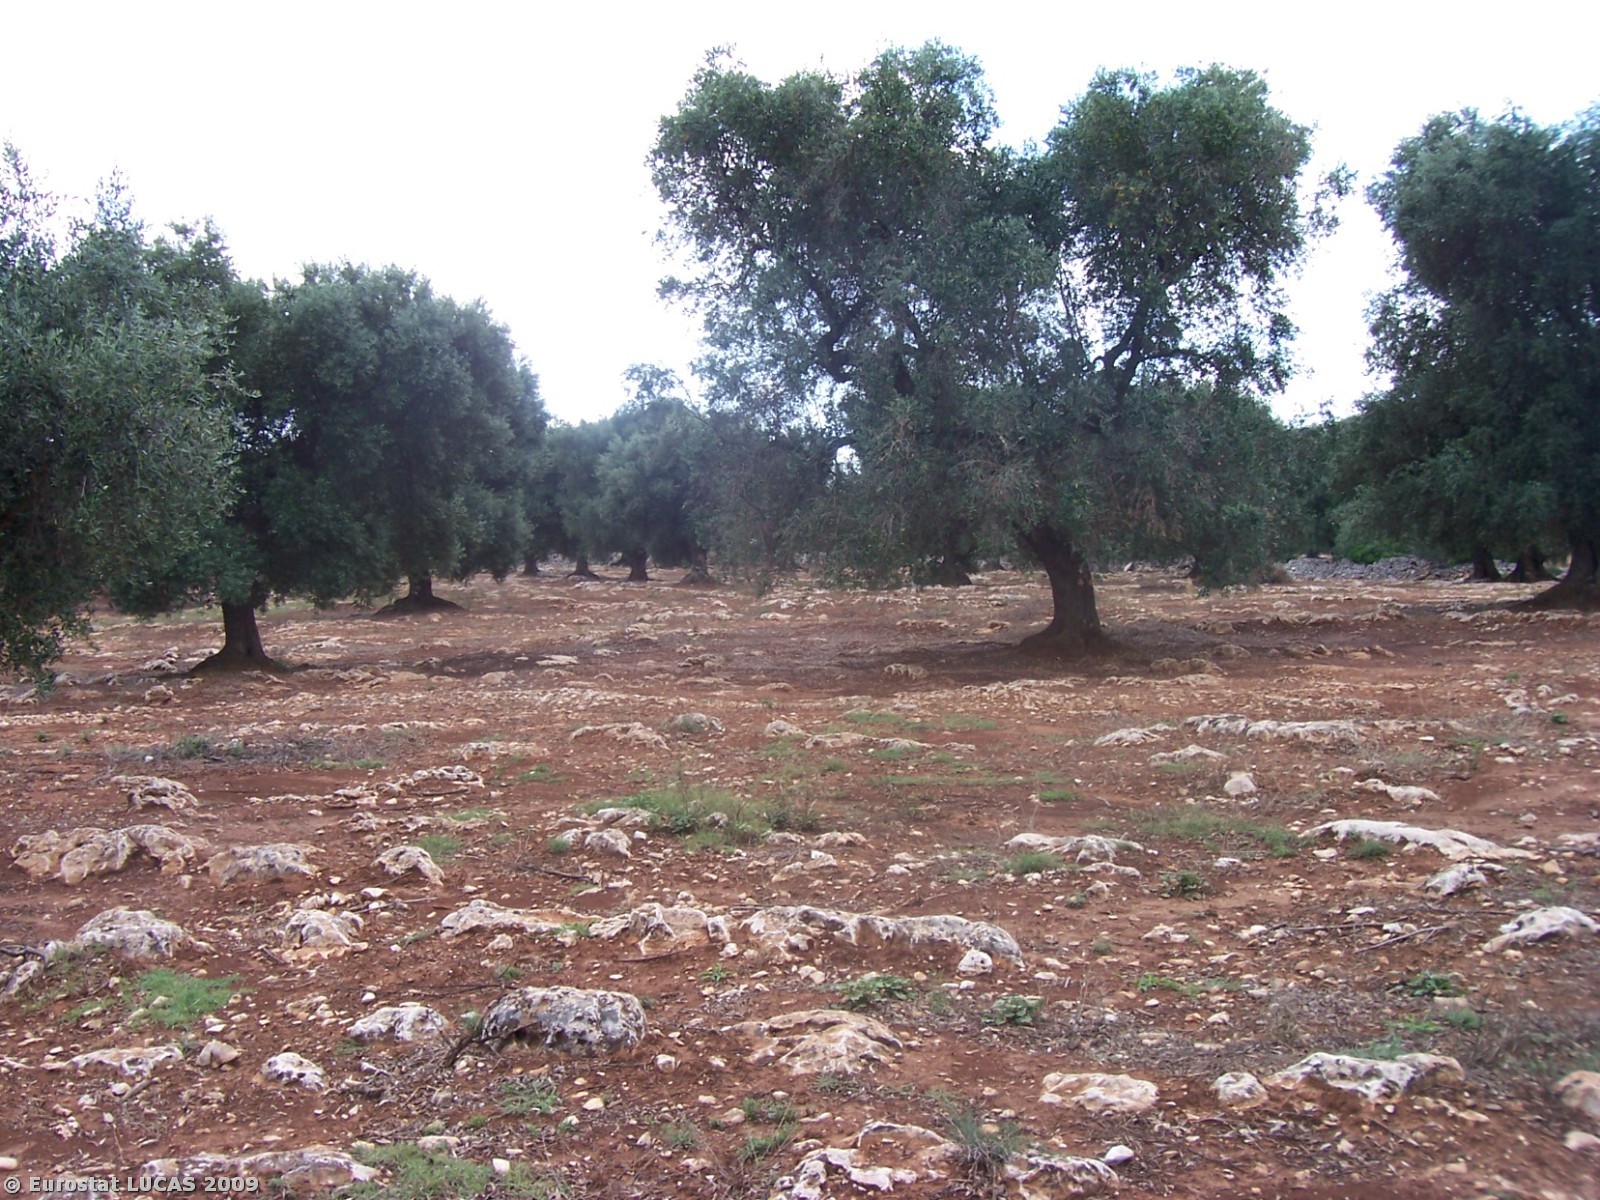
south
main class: Cropland
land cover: Olive groves
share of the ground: 50 - 75 %
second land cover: Bare land
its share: > 75 %
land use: Agriculture (excluding fallow land and kitchen gardens)
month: July
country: IT
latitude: 40.5577
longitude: 17.5463
